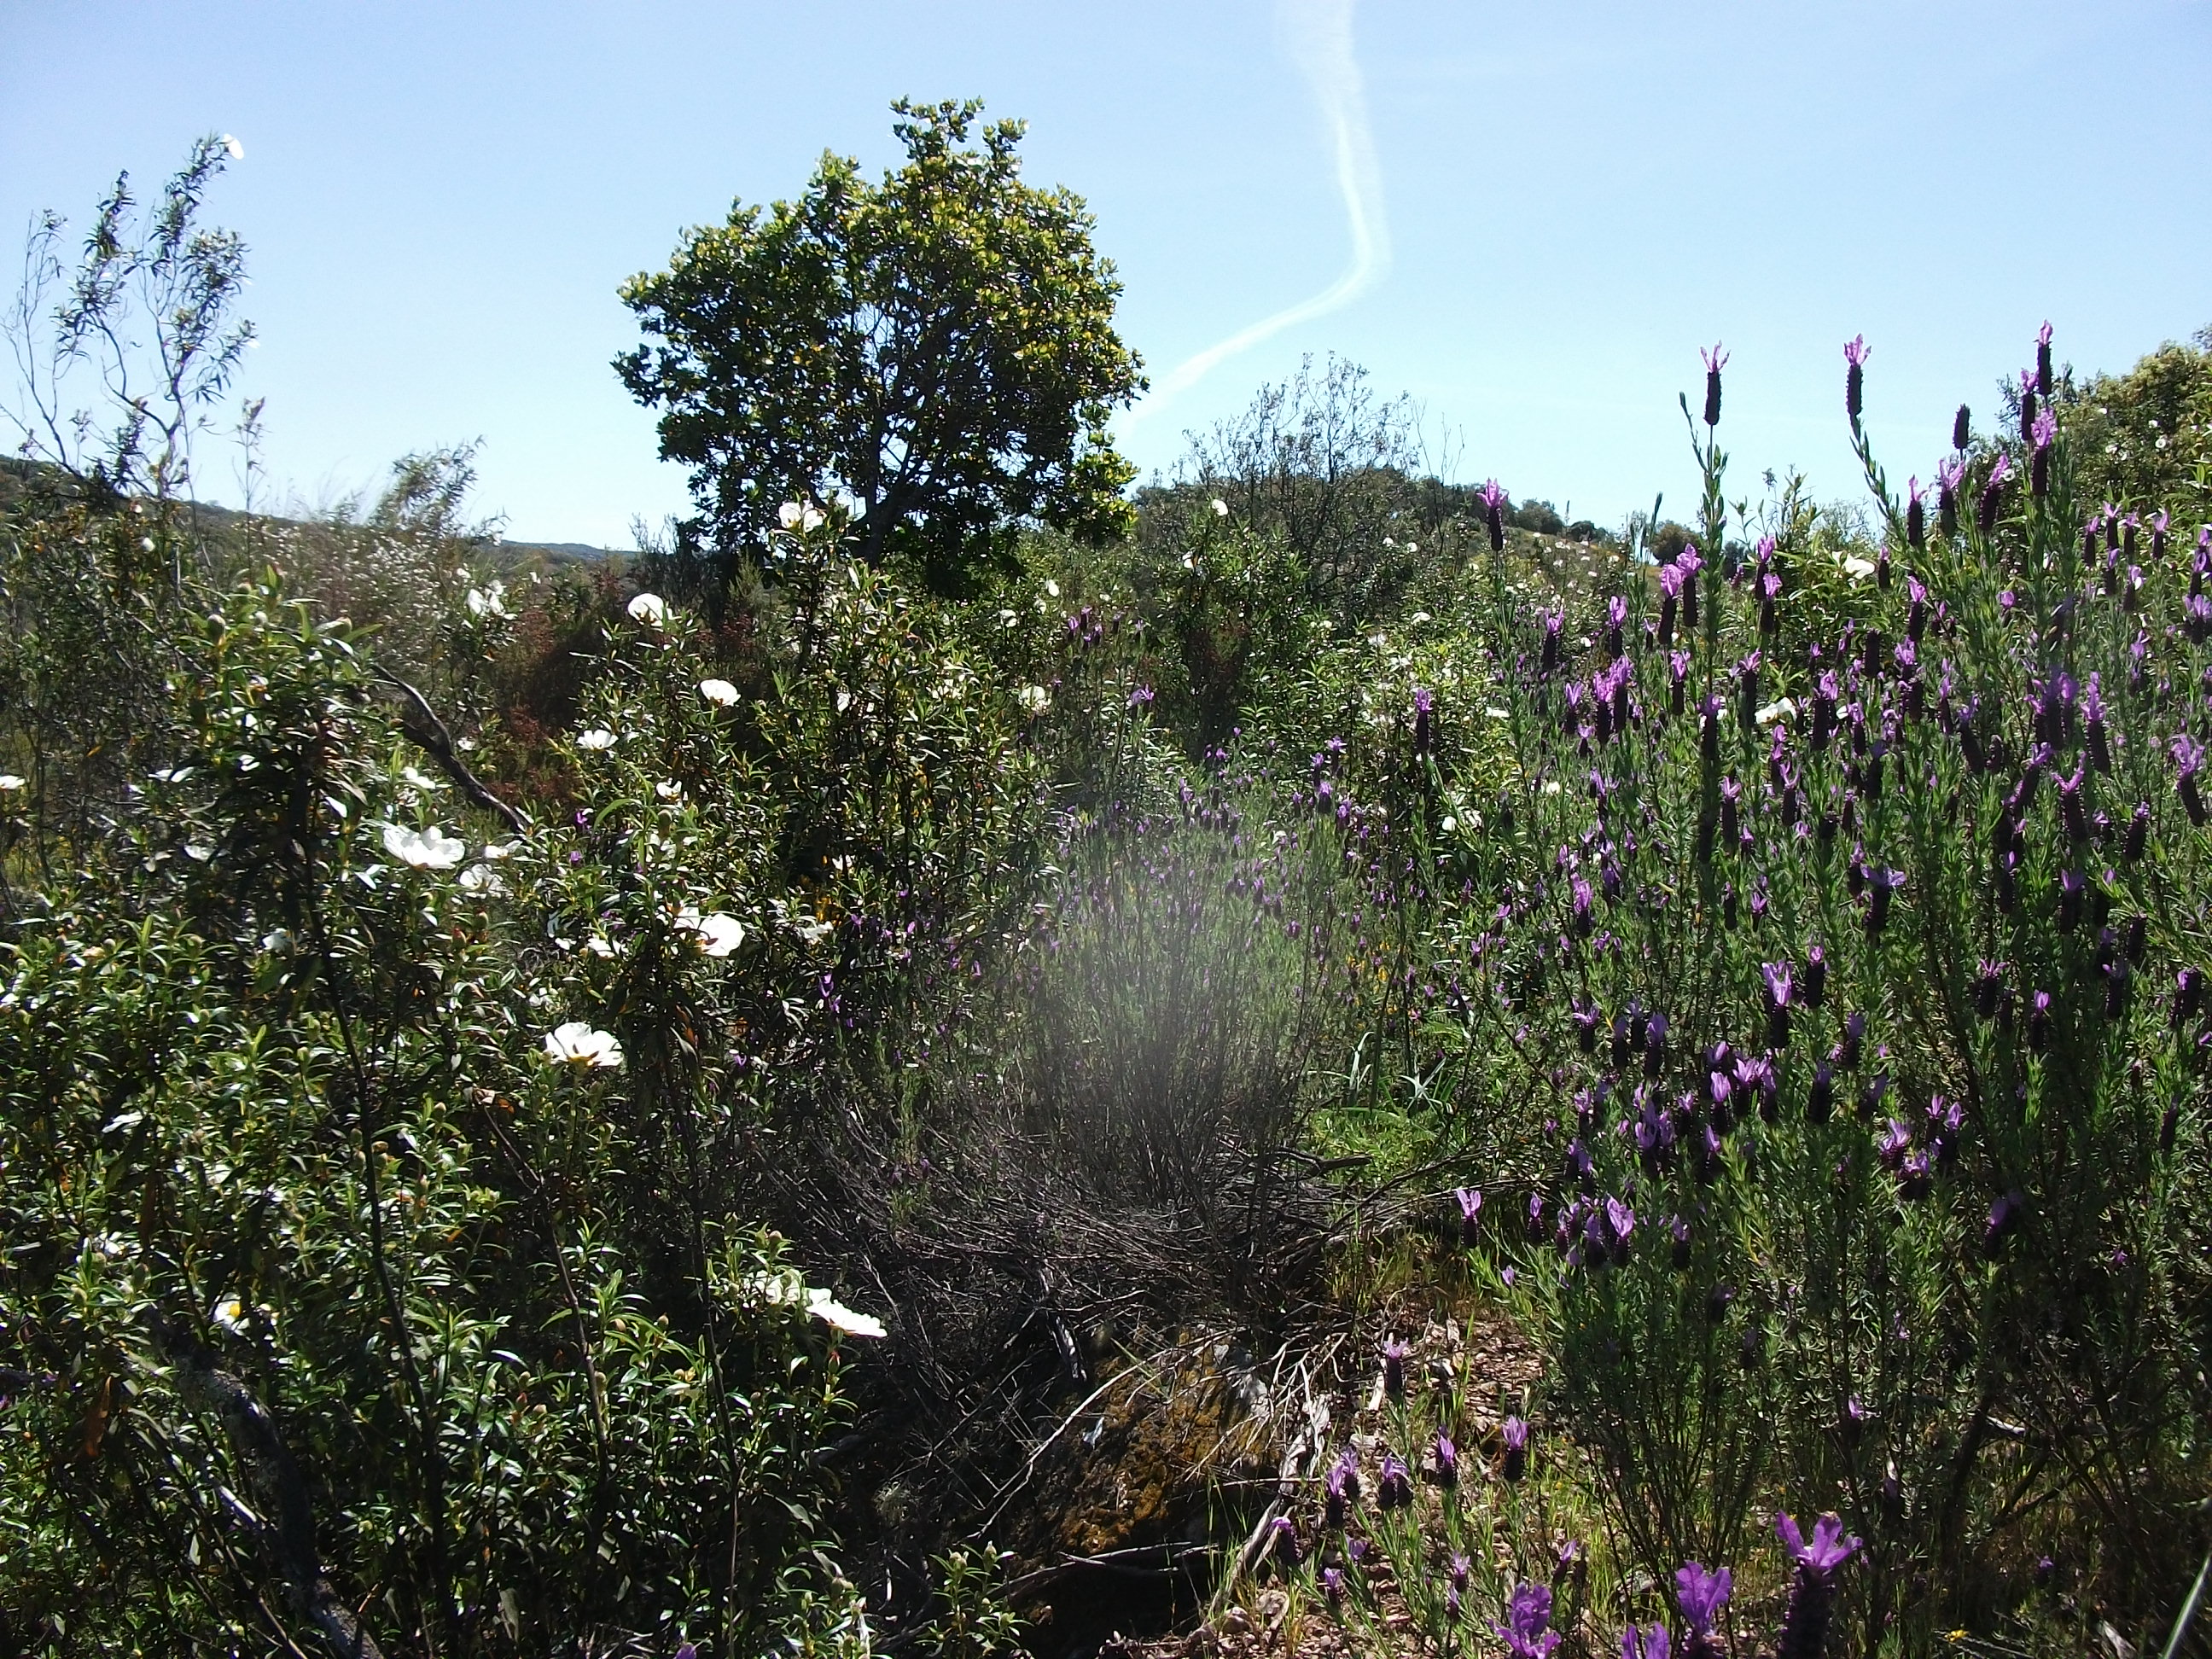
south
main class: Woodland
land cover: Broadleaved woodland
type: broadleaved evergreen forest
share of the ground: 50 - 75 %
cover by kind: broadleaved forest trees 70 %, shrubs 30 %
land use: Semi-natural and natural areas not in use
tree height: > 5 m
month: April
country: ES
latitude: 38.0138
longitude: -7.1075
